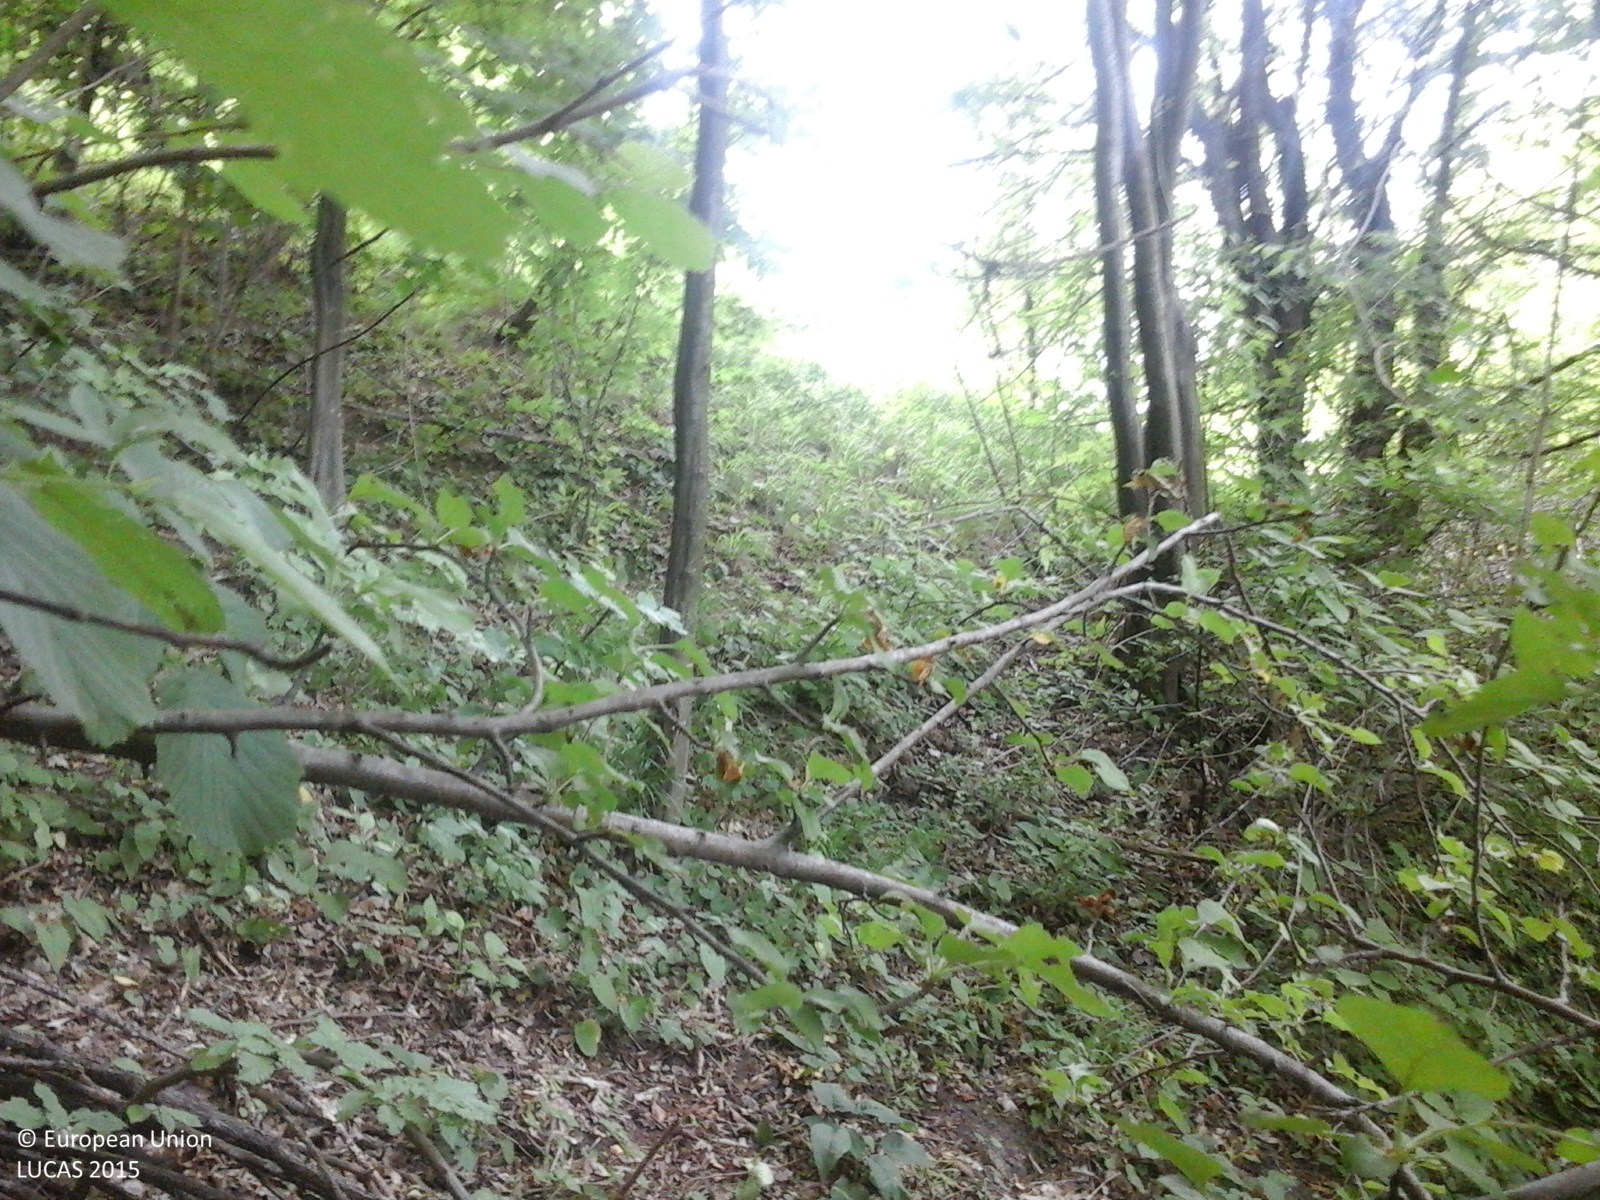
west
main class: Woodland
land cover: Broadleaved woodland
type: beech forest
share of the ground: > 75 %
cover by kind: broadleaved forest trees 100 %
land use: Forestry
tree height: > 5 m
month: June
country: RO
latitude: 46.5316
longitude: 26.7112
